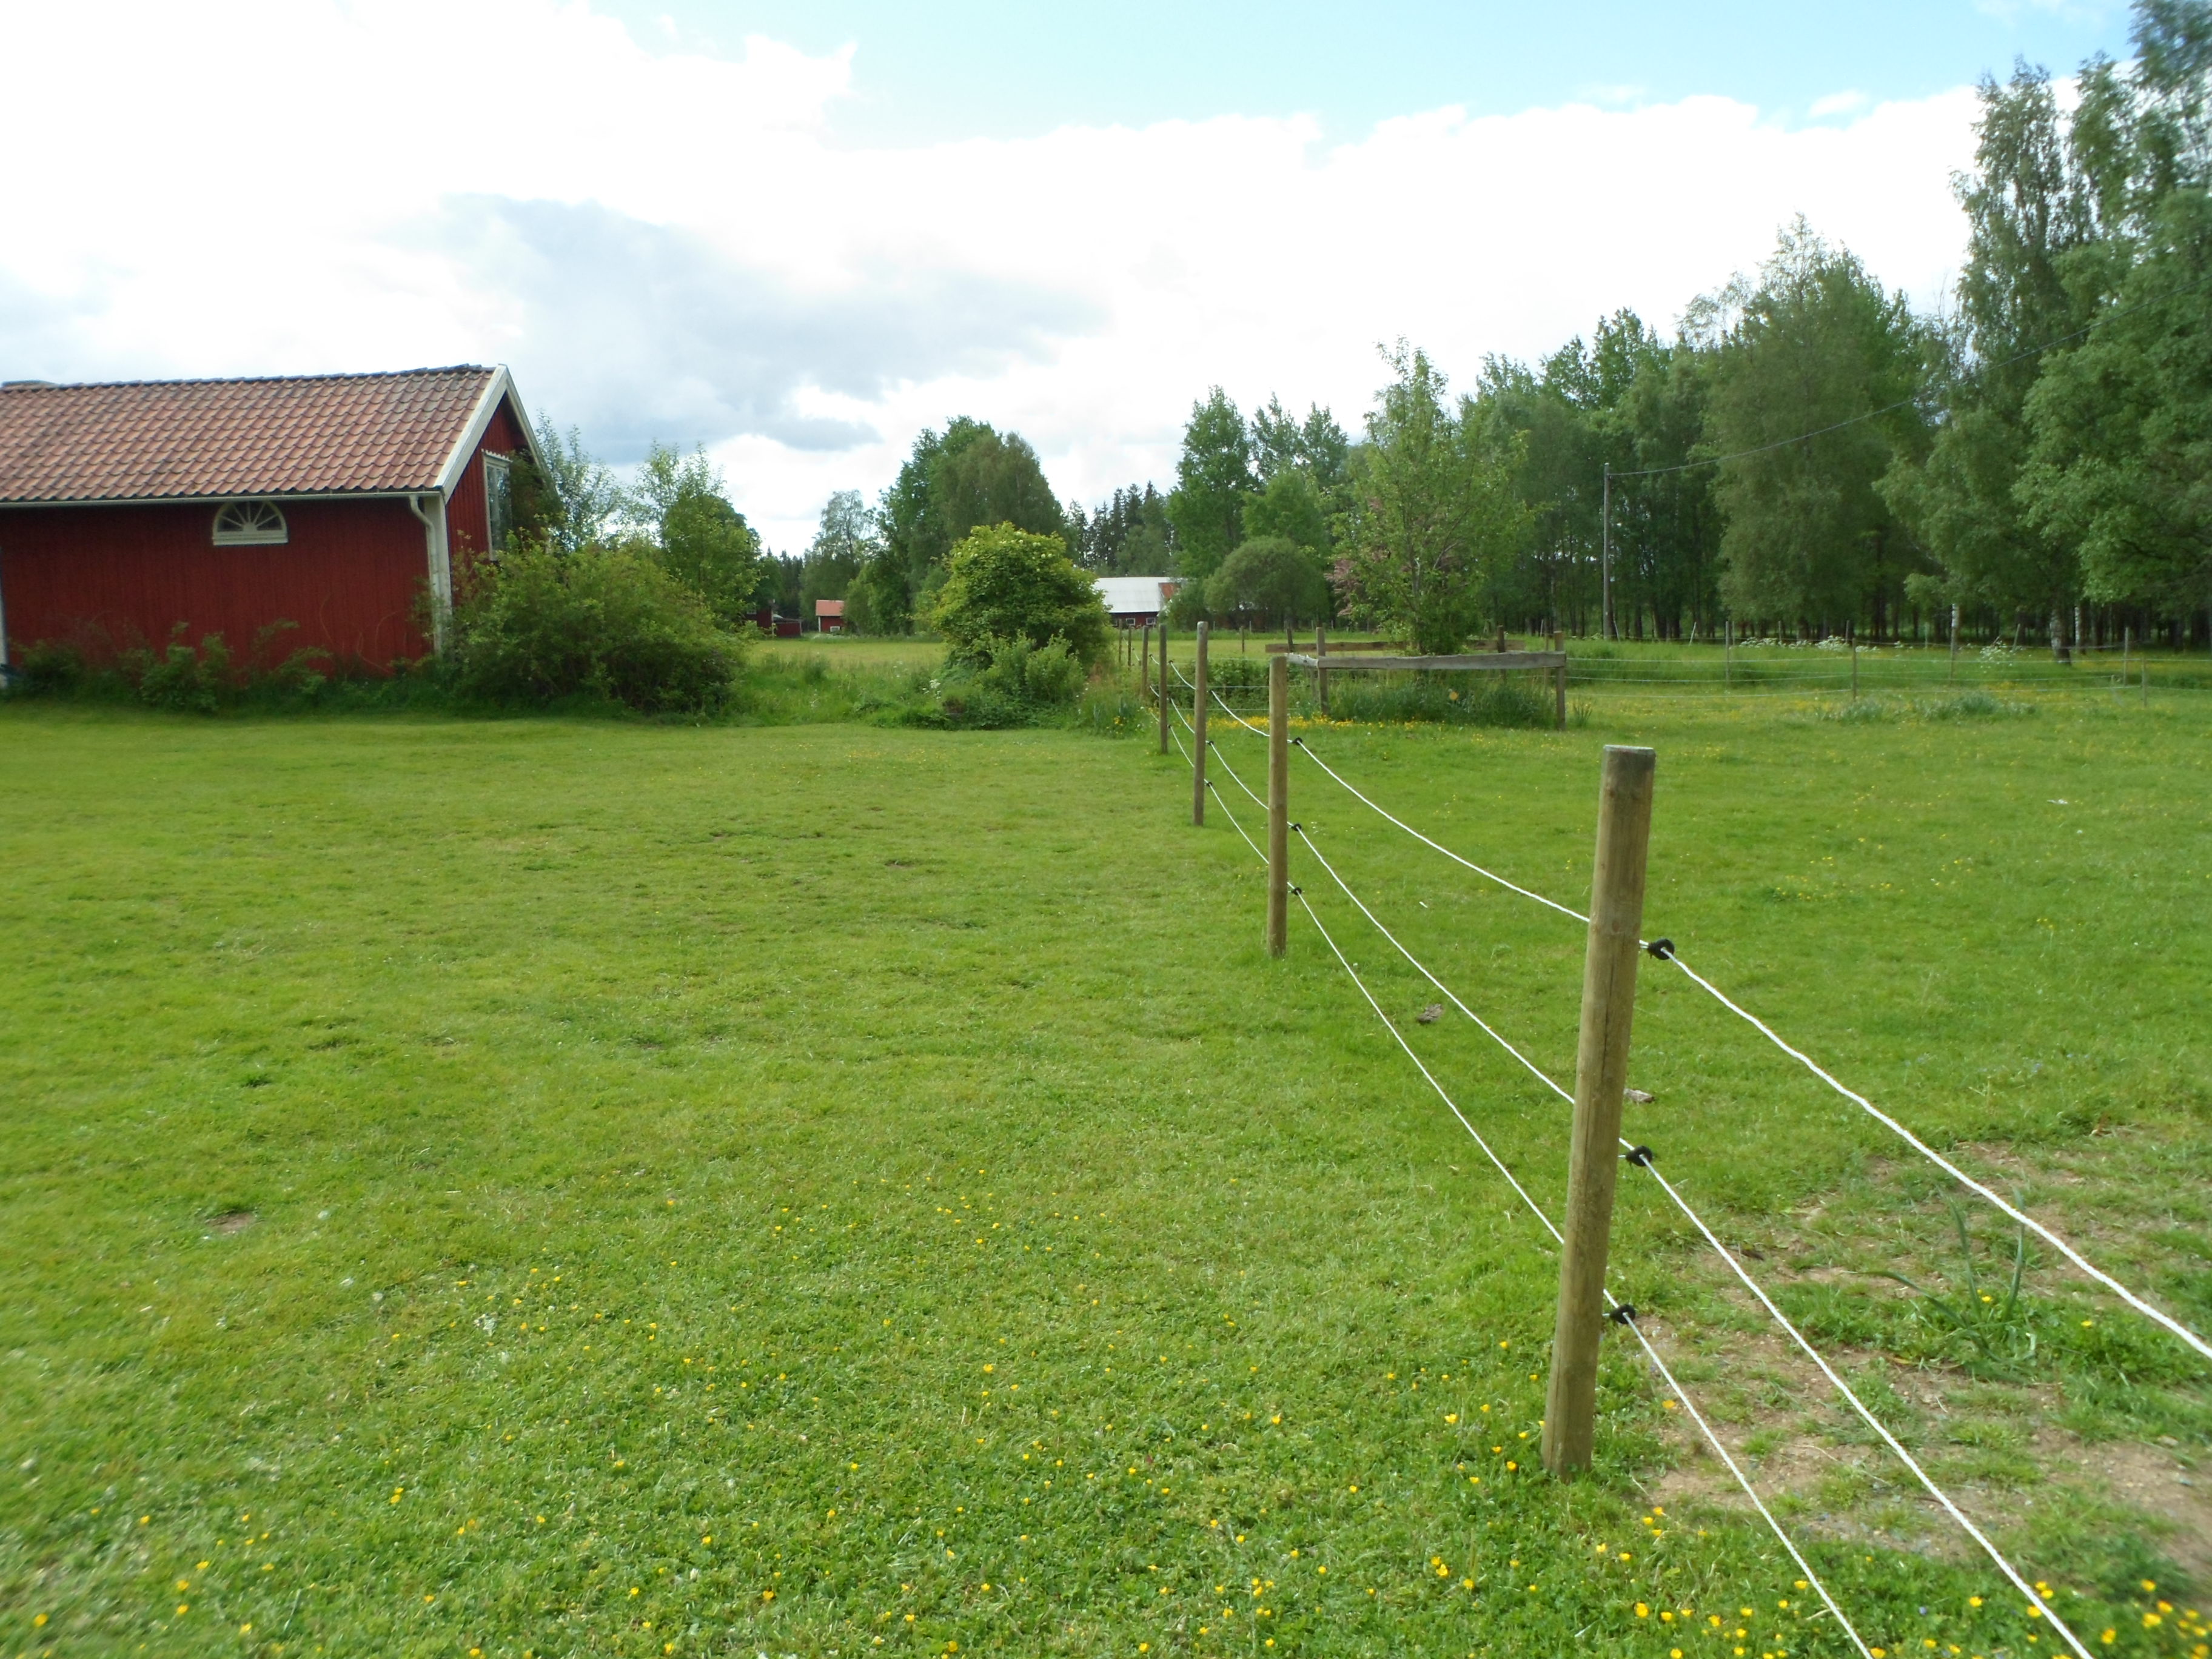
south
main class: Grassland
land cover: Grassland without tree/shrub cover
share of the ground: > 75 %
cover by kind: herbaceous plants 100 %
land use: Residential
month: June
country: SE
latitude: 57.4163
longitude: 14.1746
